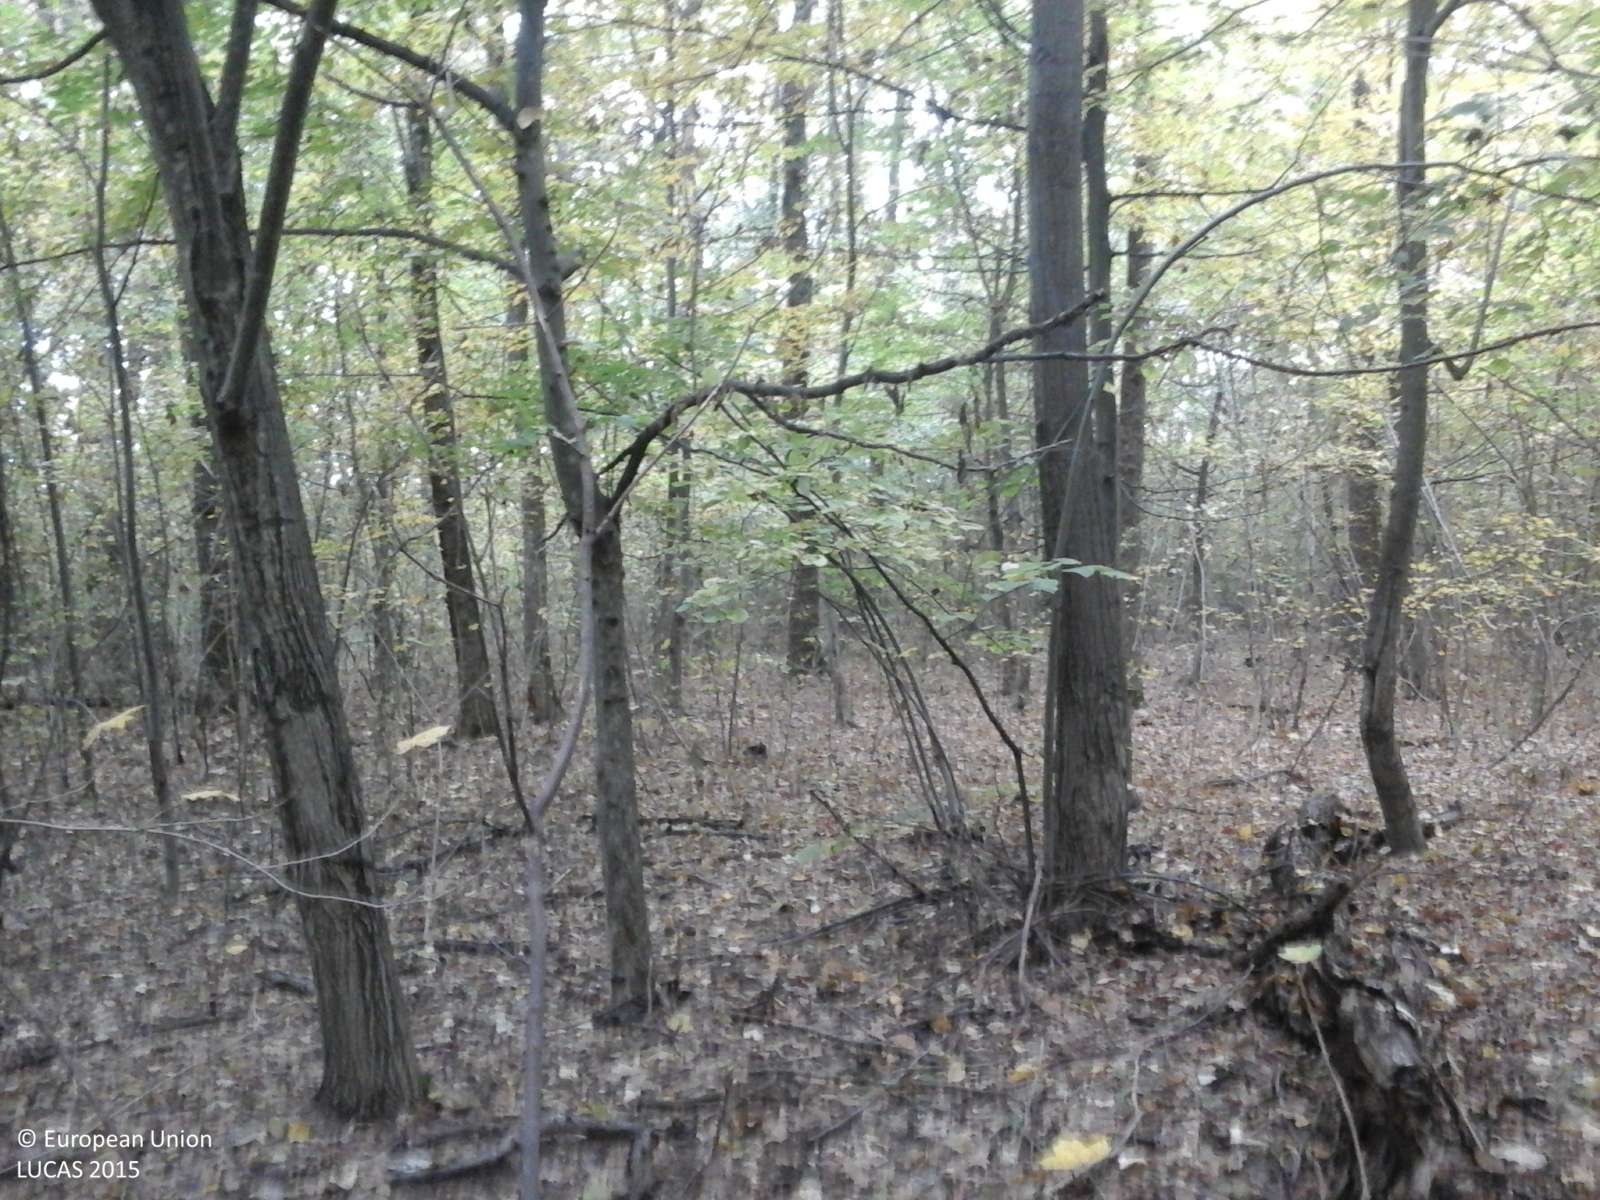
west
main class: Woodland
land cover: Broadleaved woodland
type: beech forest
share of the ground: > 75 %
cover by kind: broadleaved forest trees 100 %
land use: Forestry
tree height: > 5 m
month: October
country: RO
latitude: 44.7287
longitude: 26.0282
